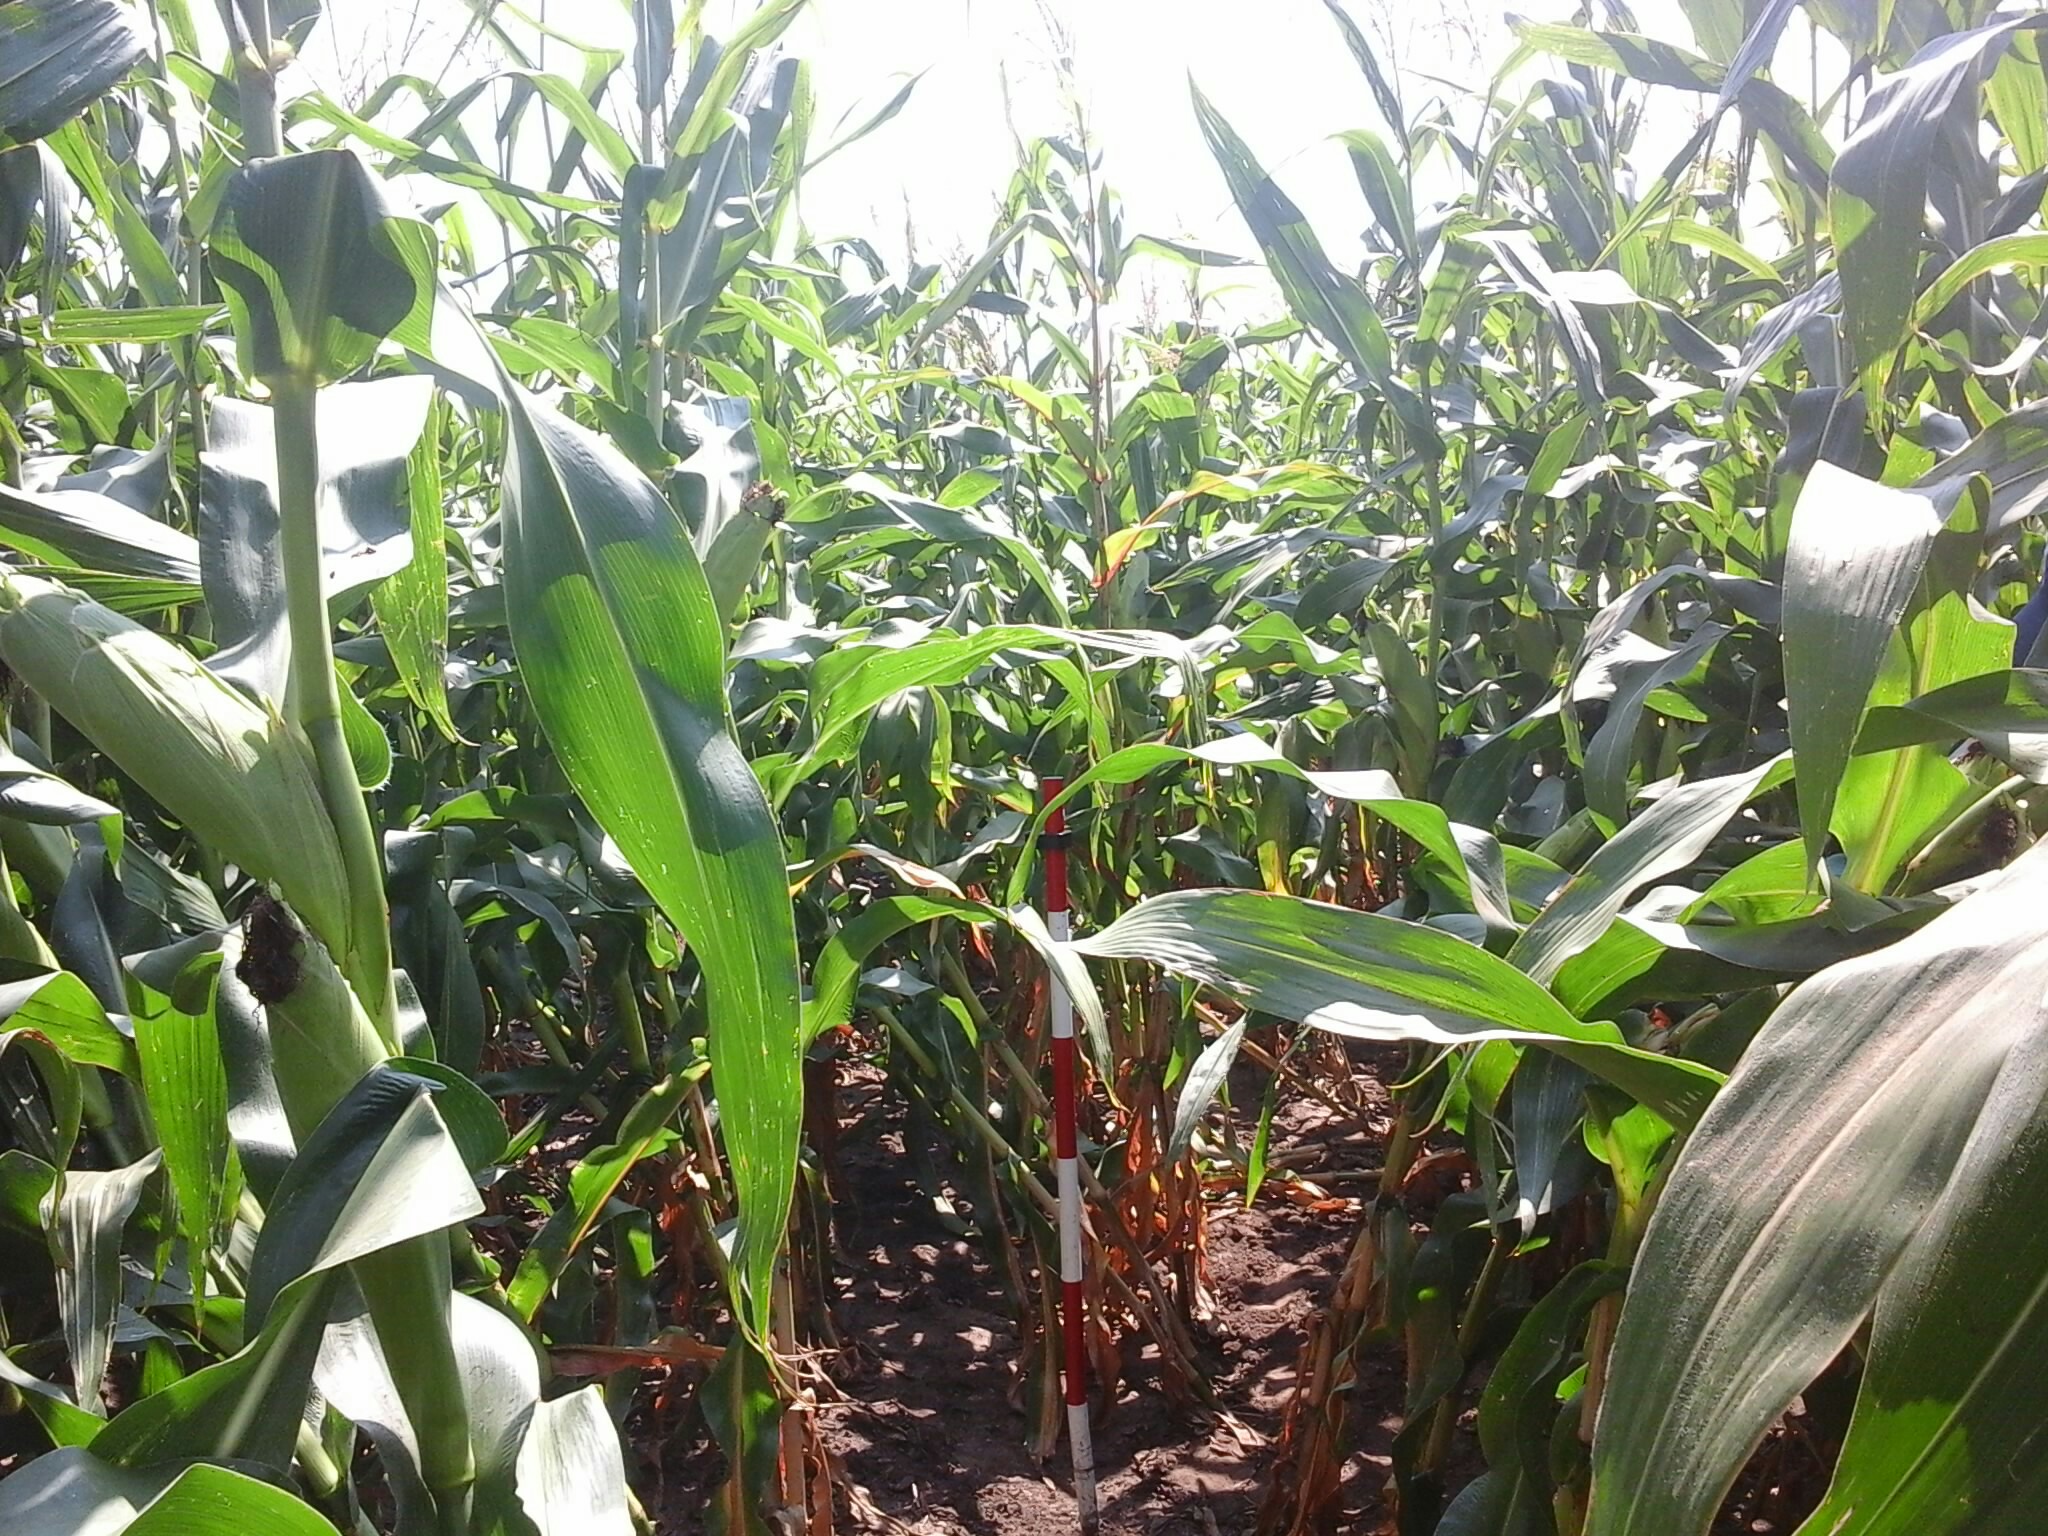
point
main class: Cropland
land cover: Maize
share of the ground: > 75 %
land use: Agriculture (excluding fallow land and kitchen gardens)
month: August
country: HU
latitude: 47.3857
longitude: 18.5312
